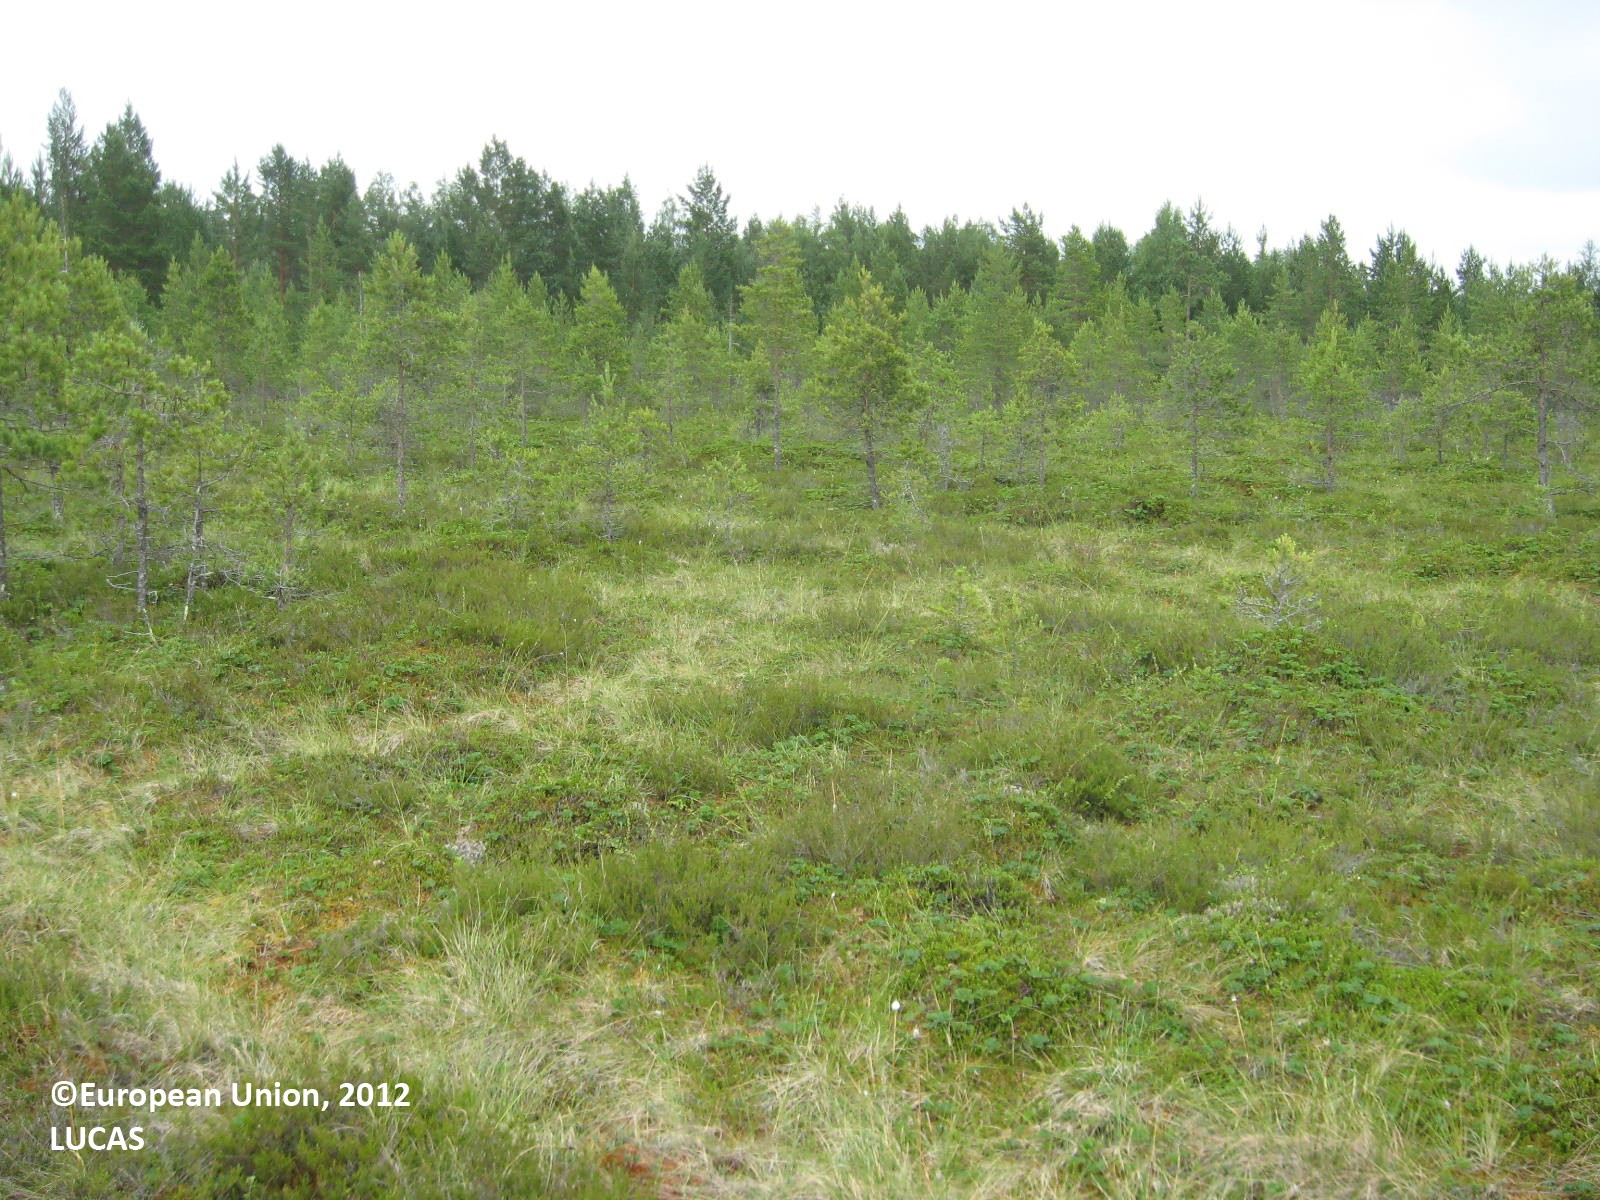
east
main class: Woodland
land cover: Pine dominated coniferous woodland
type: mire and swamp forests
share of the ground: 10 - 25 %
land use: Semi-natural and natural areas not in use
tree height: < 5 m
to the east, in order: Pine dominated coniferous woodland; Ditches and canals; Lines of trees; Tracks; Pine dominated coniferous woodland; Ditches and canals; Pine dominated mixed woodland; Ditches and canals; Other mixed woodland; Ditches and canals; Other mixed woodland; Ditches and canals; Broadleaved woodland; Ditches and canals; Broadleaved woodland; Ditches and canals; Broadleaved woodland; Spruce dominated mixed woodland
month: July
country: FI
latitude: 62.5065
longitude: 22.5412
